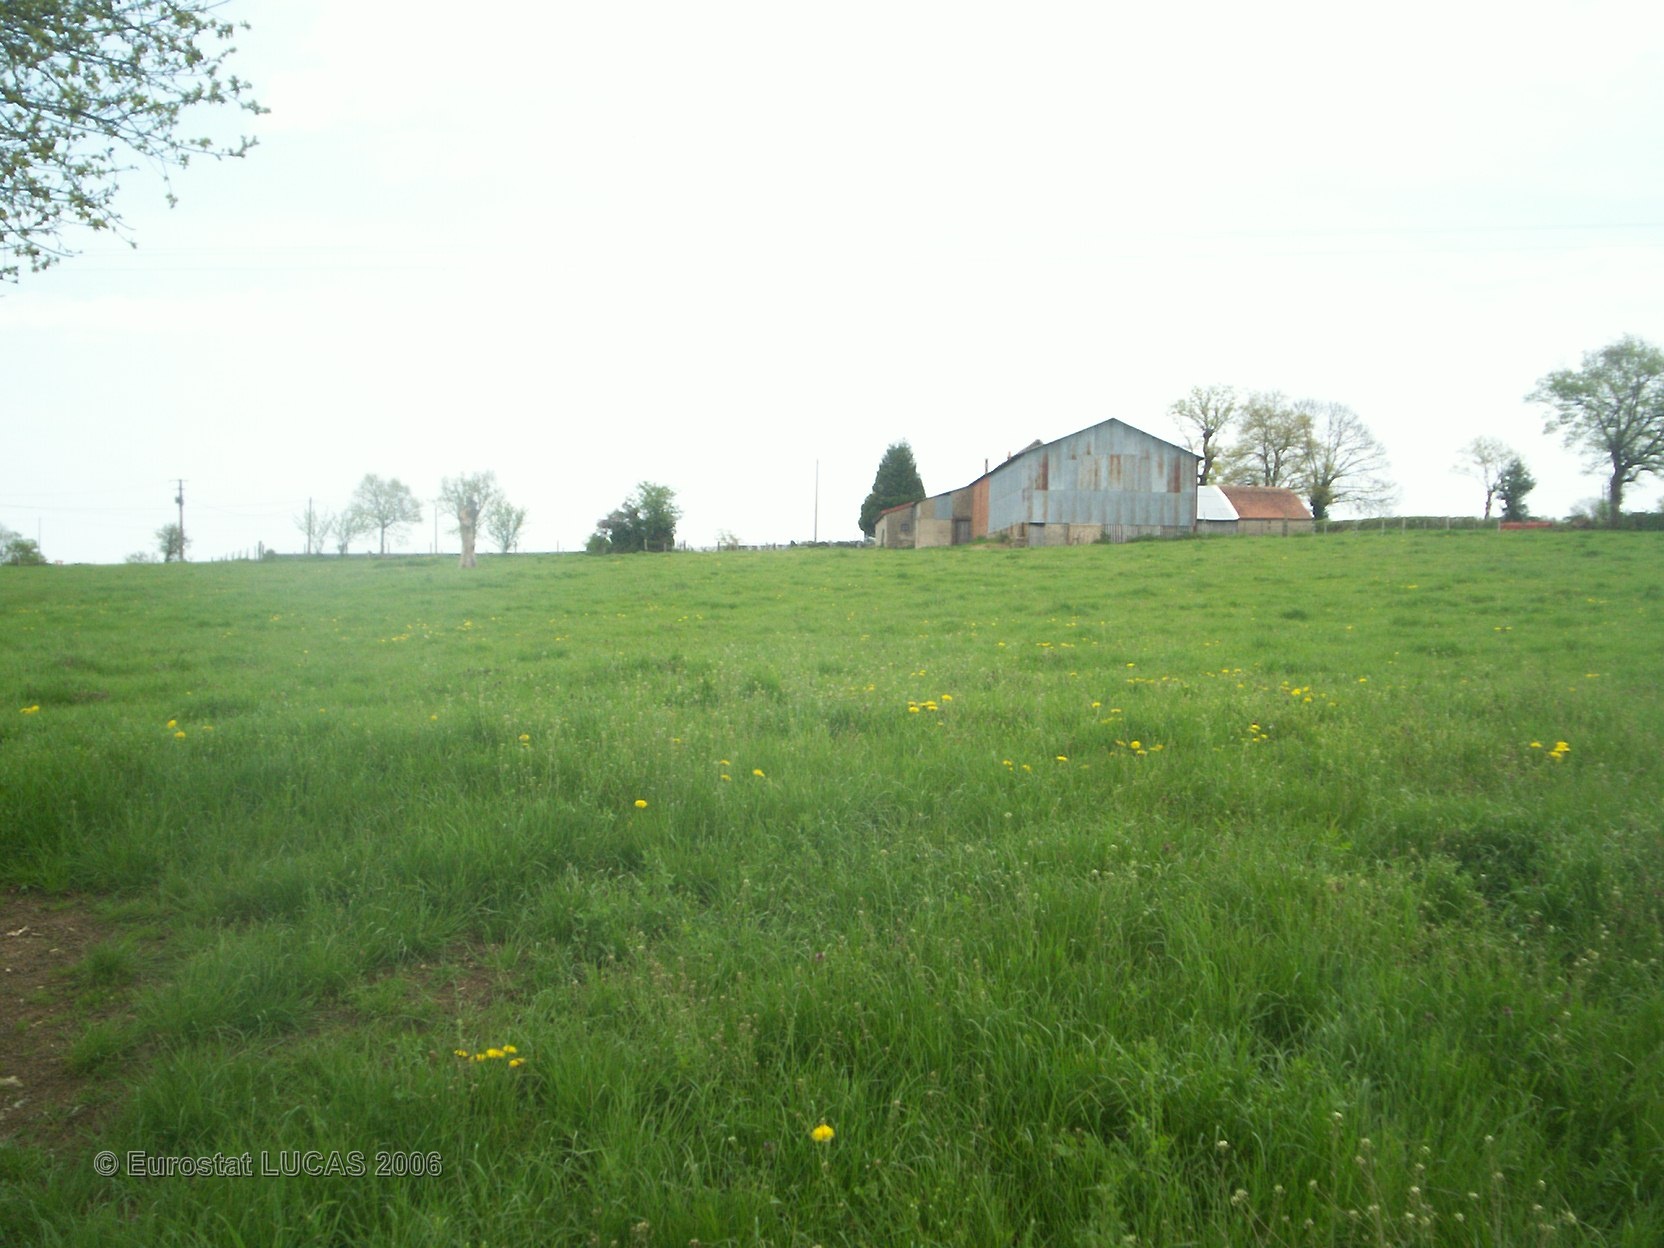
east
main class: Grassland
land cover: Grassland with sparse tree/shrub cover
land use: Agriculture (excluding fallow land and kitchen gardens)
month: May
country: FR
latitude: 46.4184
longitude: 3.1151
